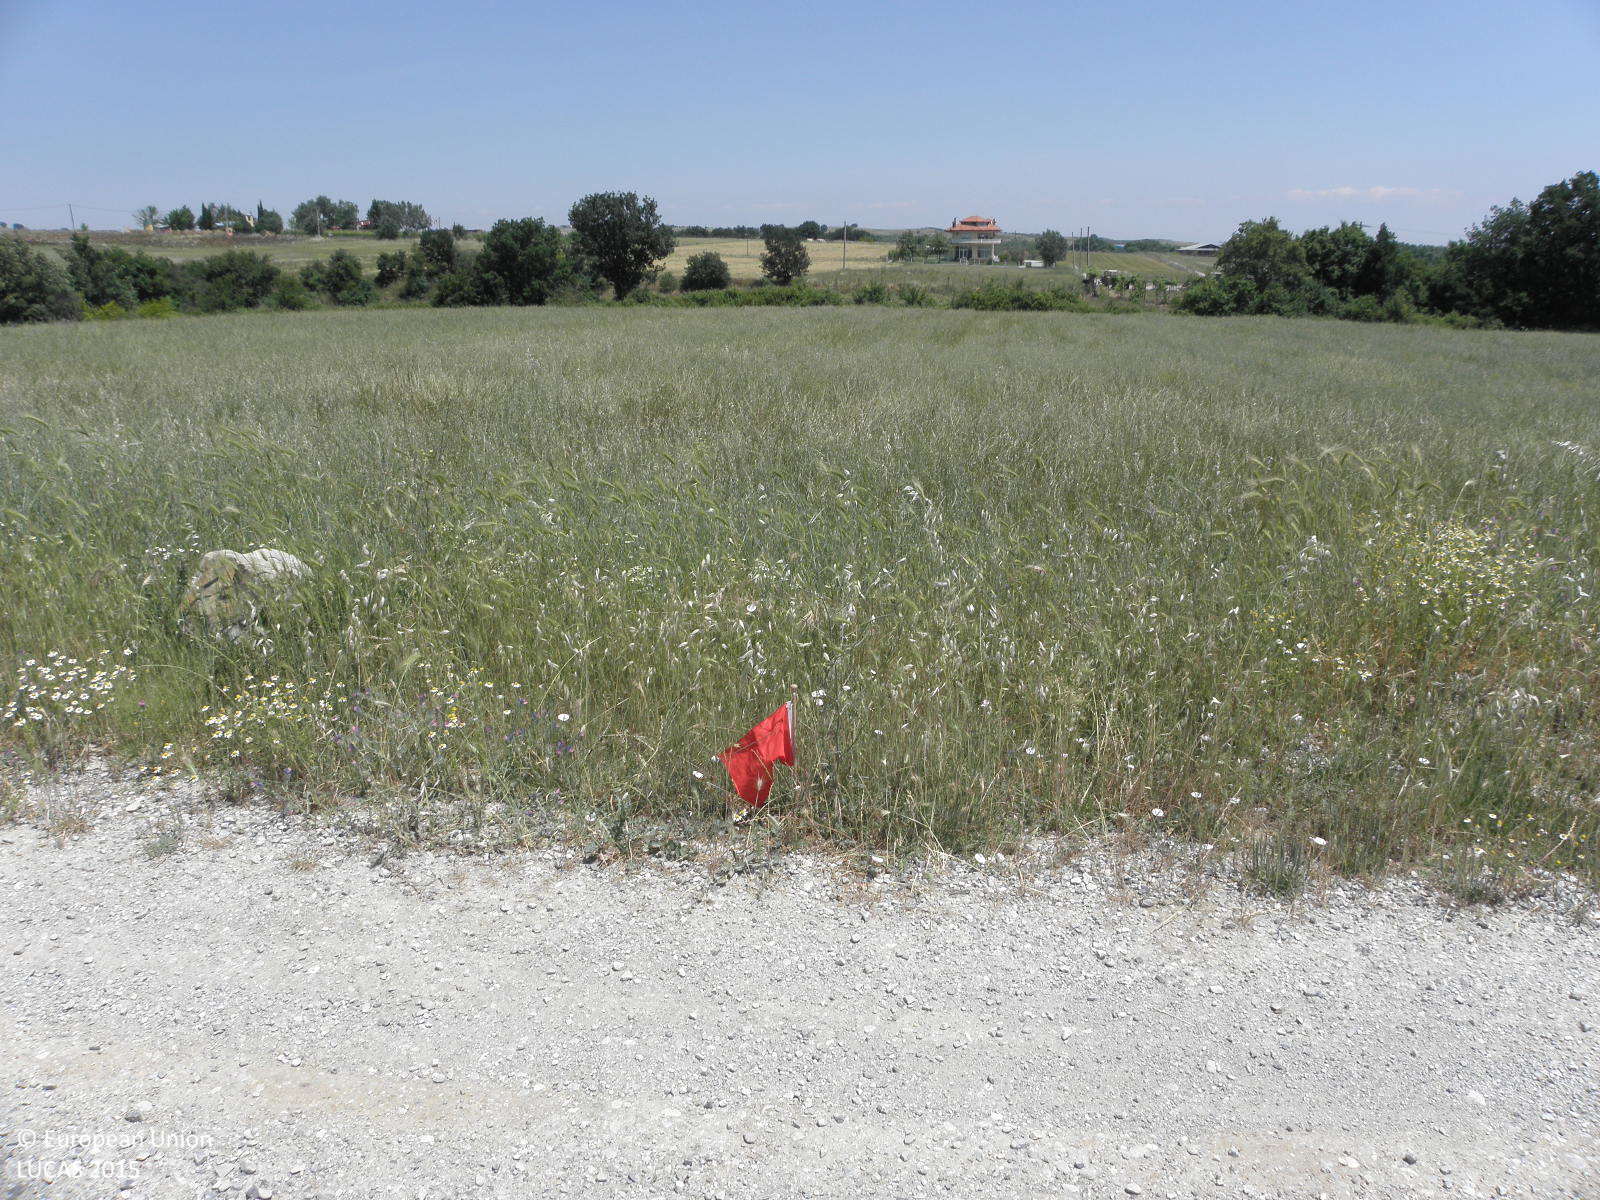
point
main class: Cropland
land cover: Barley
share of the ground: > 75 %
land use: Agriculture (excluding fallow land and kitchen gardens)
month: May
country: GR
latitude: 40.2929
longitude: 22.4556
